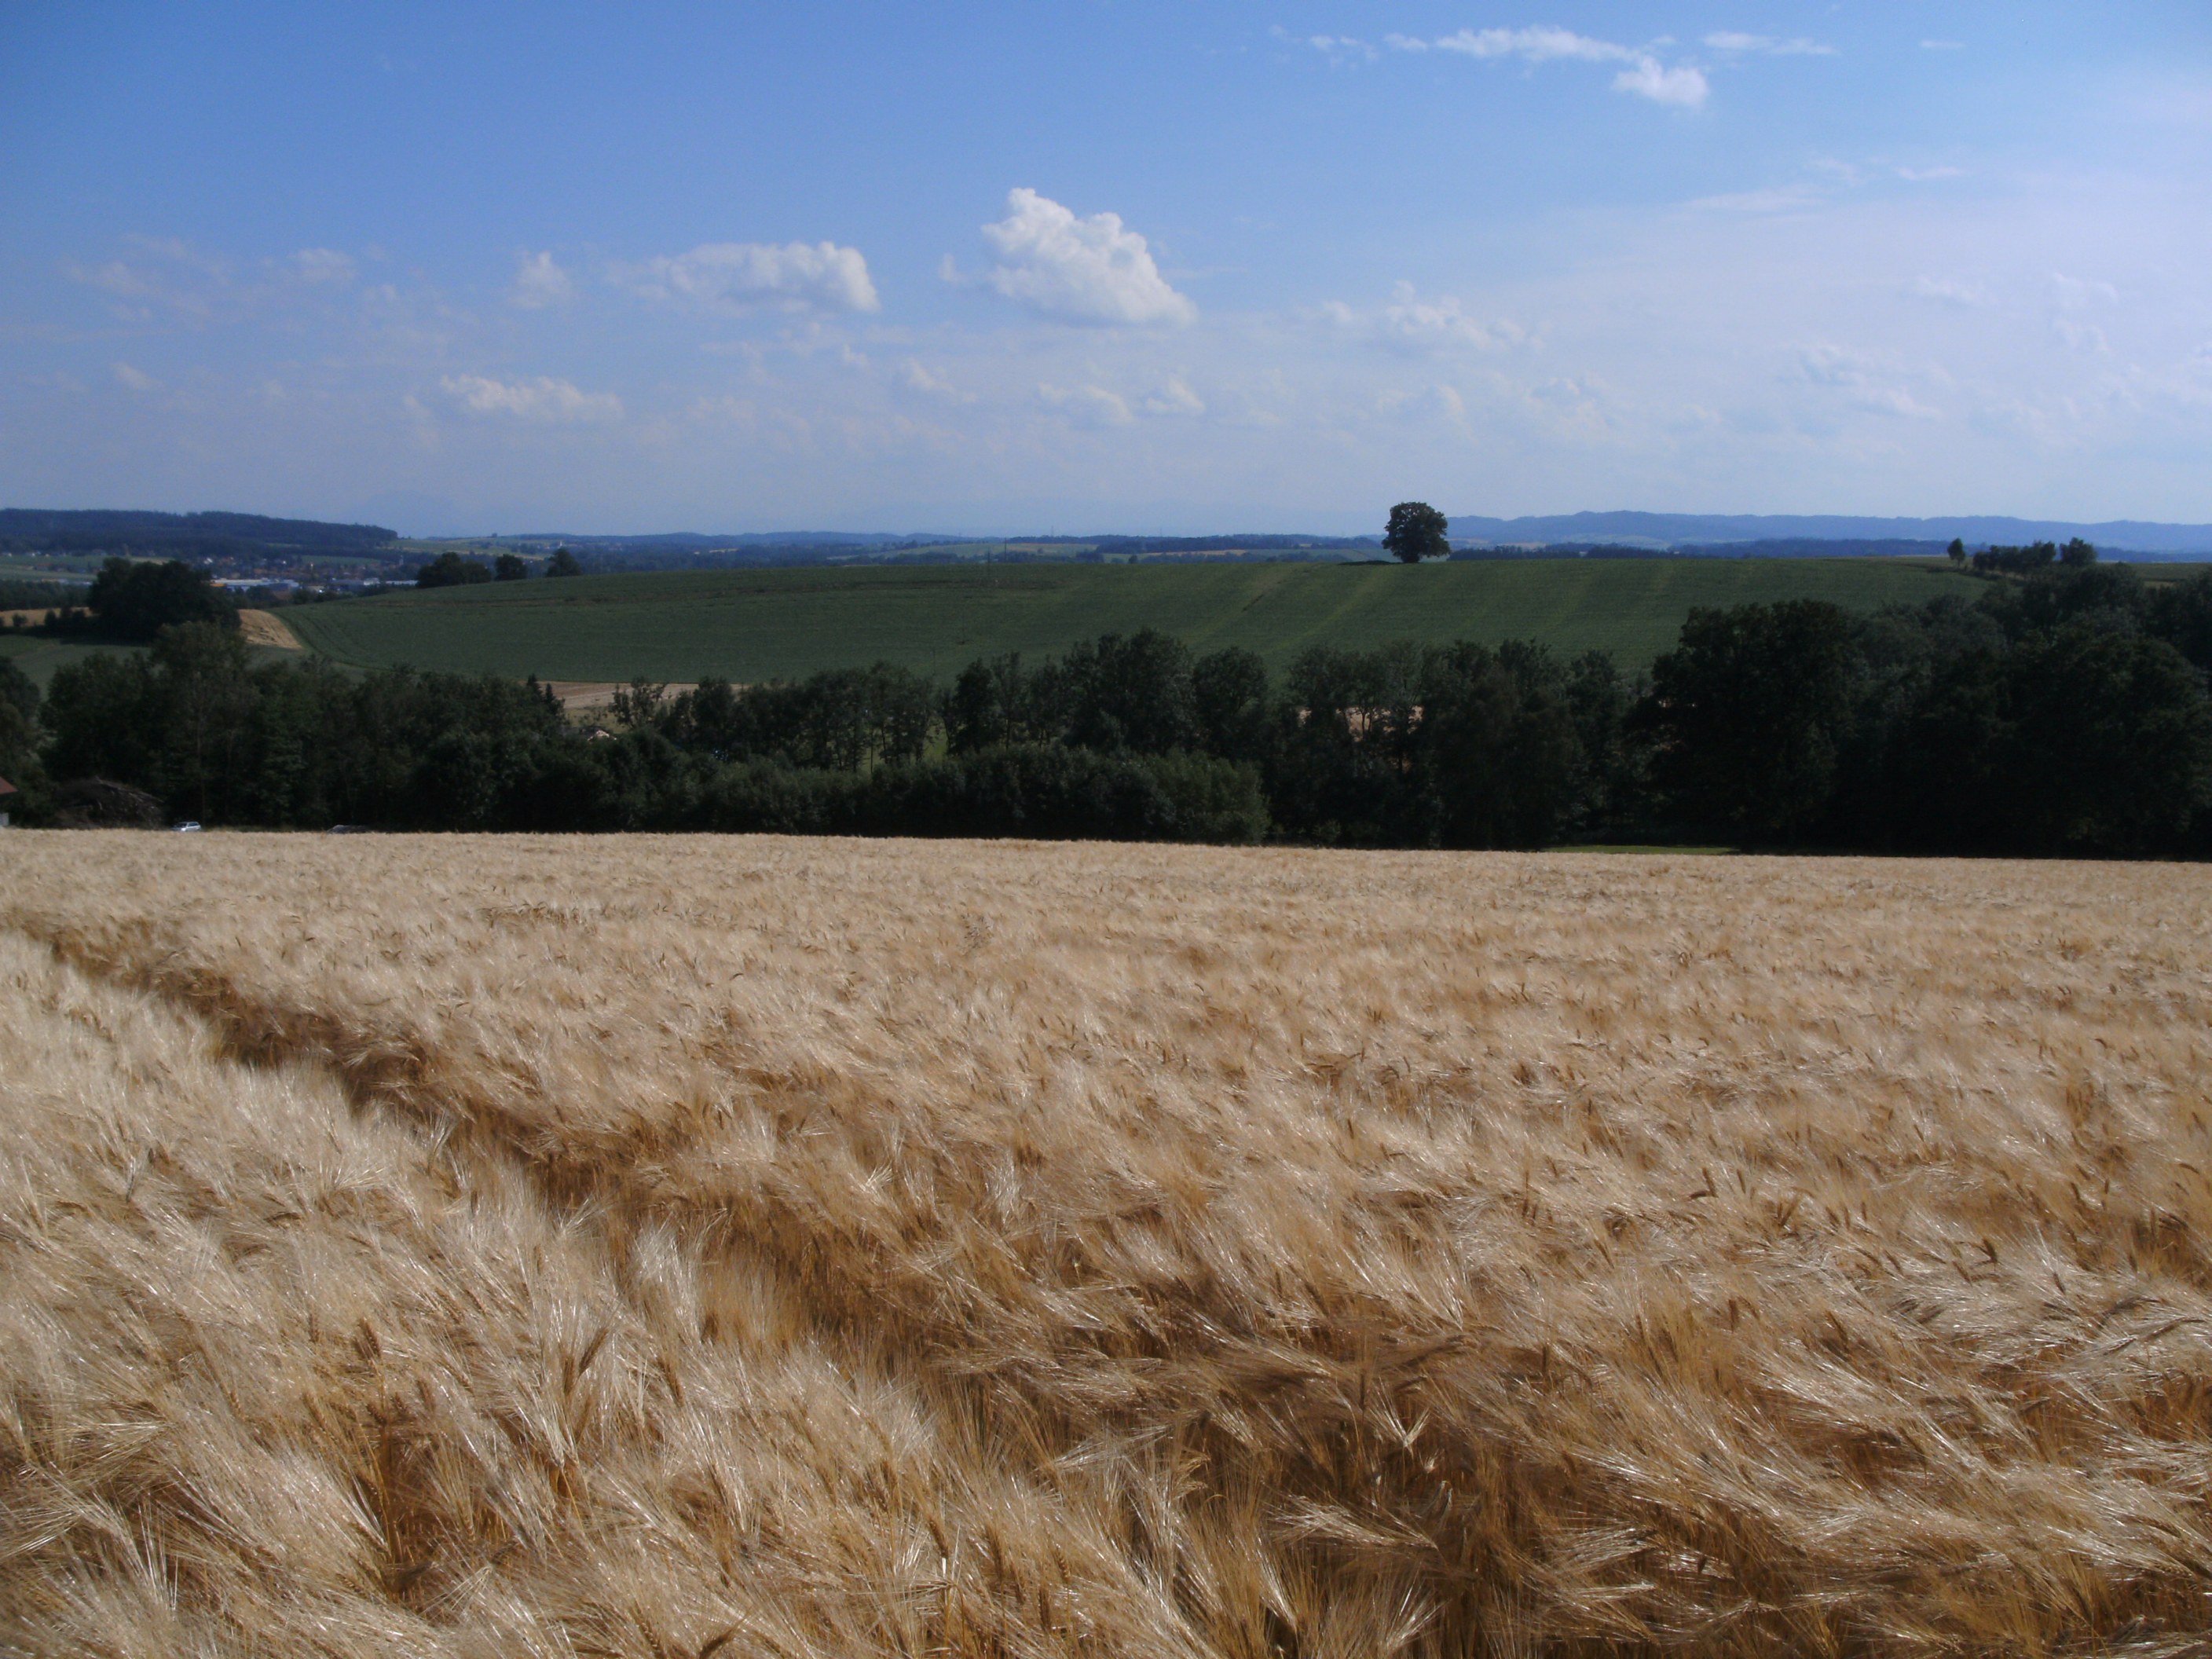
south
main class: Cropland
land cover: Barley
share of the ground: > 75 %
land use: Agriculture (excluding fallow land and kitchen gardens)
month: June
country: AT
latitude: 48.2505
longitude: 13.7301
